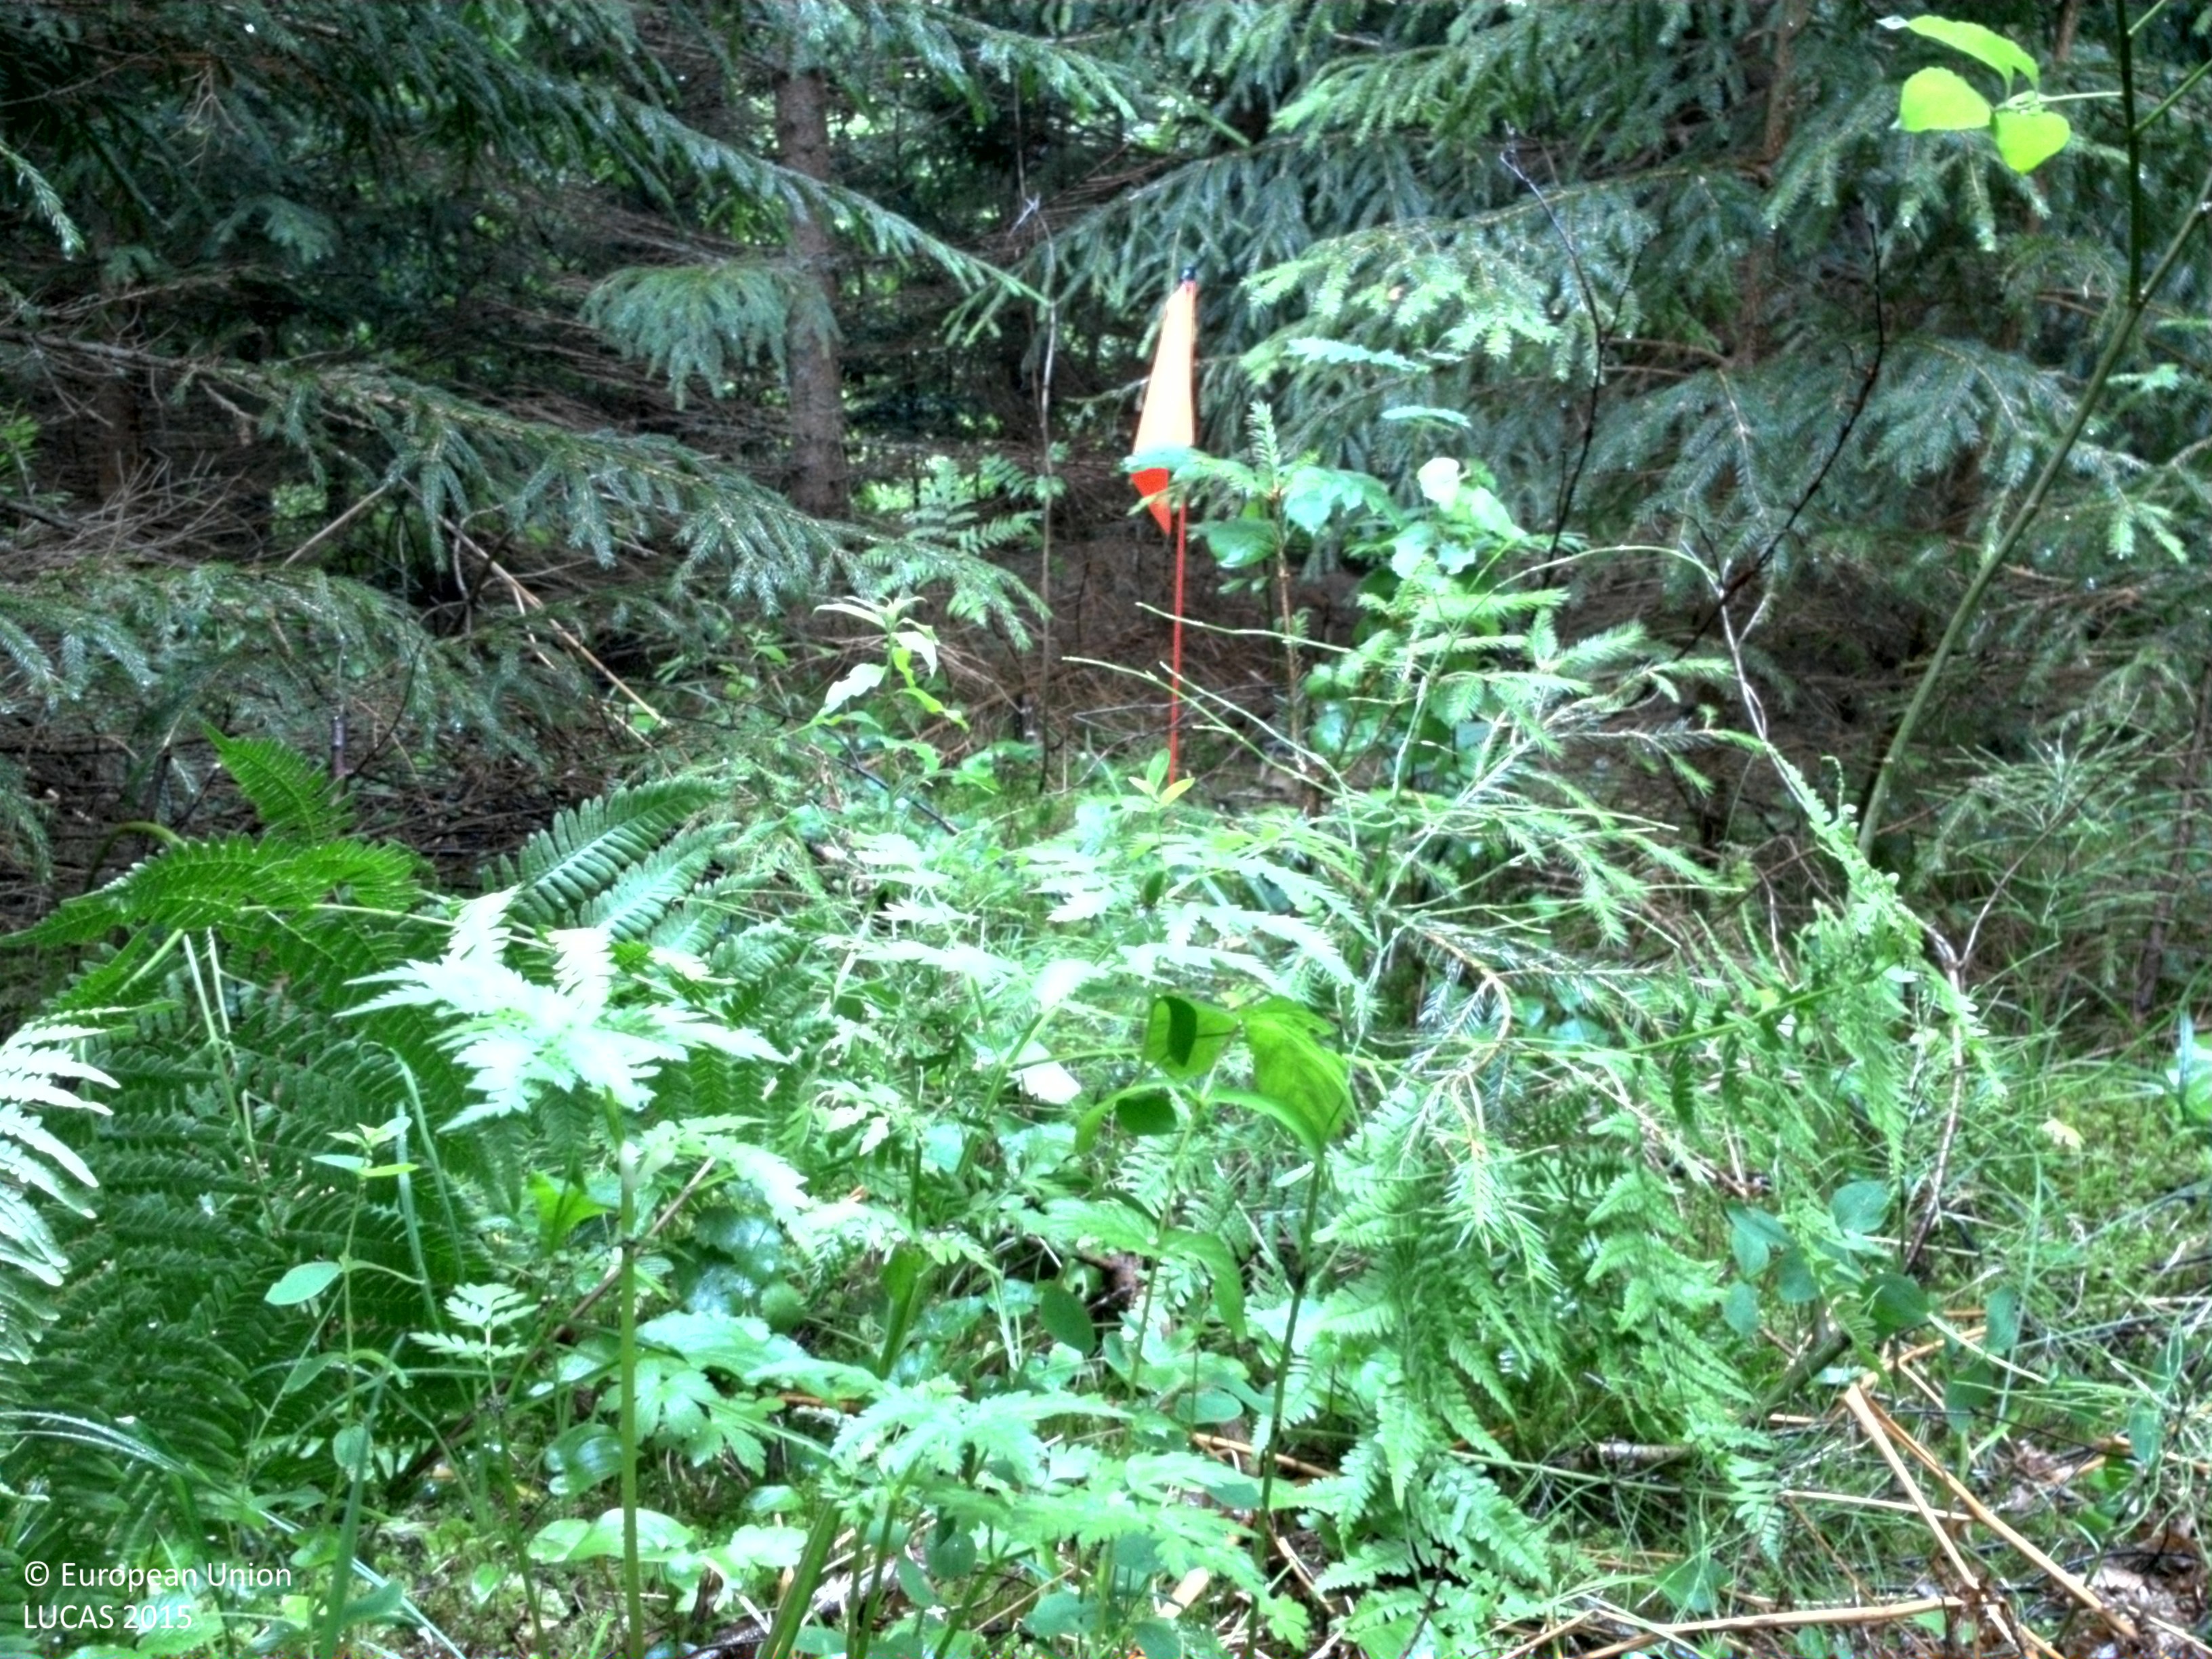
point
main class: Woodland
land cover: Spruce dominated coniferous woodland
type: boreal forest
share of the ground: > 75 %
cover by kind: coniferous forest trees 90 %, herbaceous plants 10 %
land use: Forestry
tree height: < 5 m
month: July
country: SE
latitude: 59.9934
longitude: 18.5489
